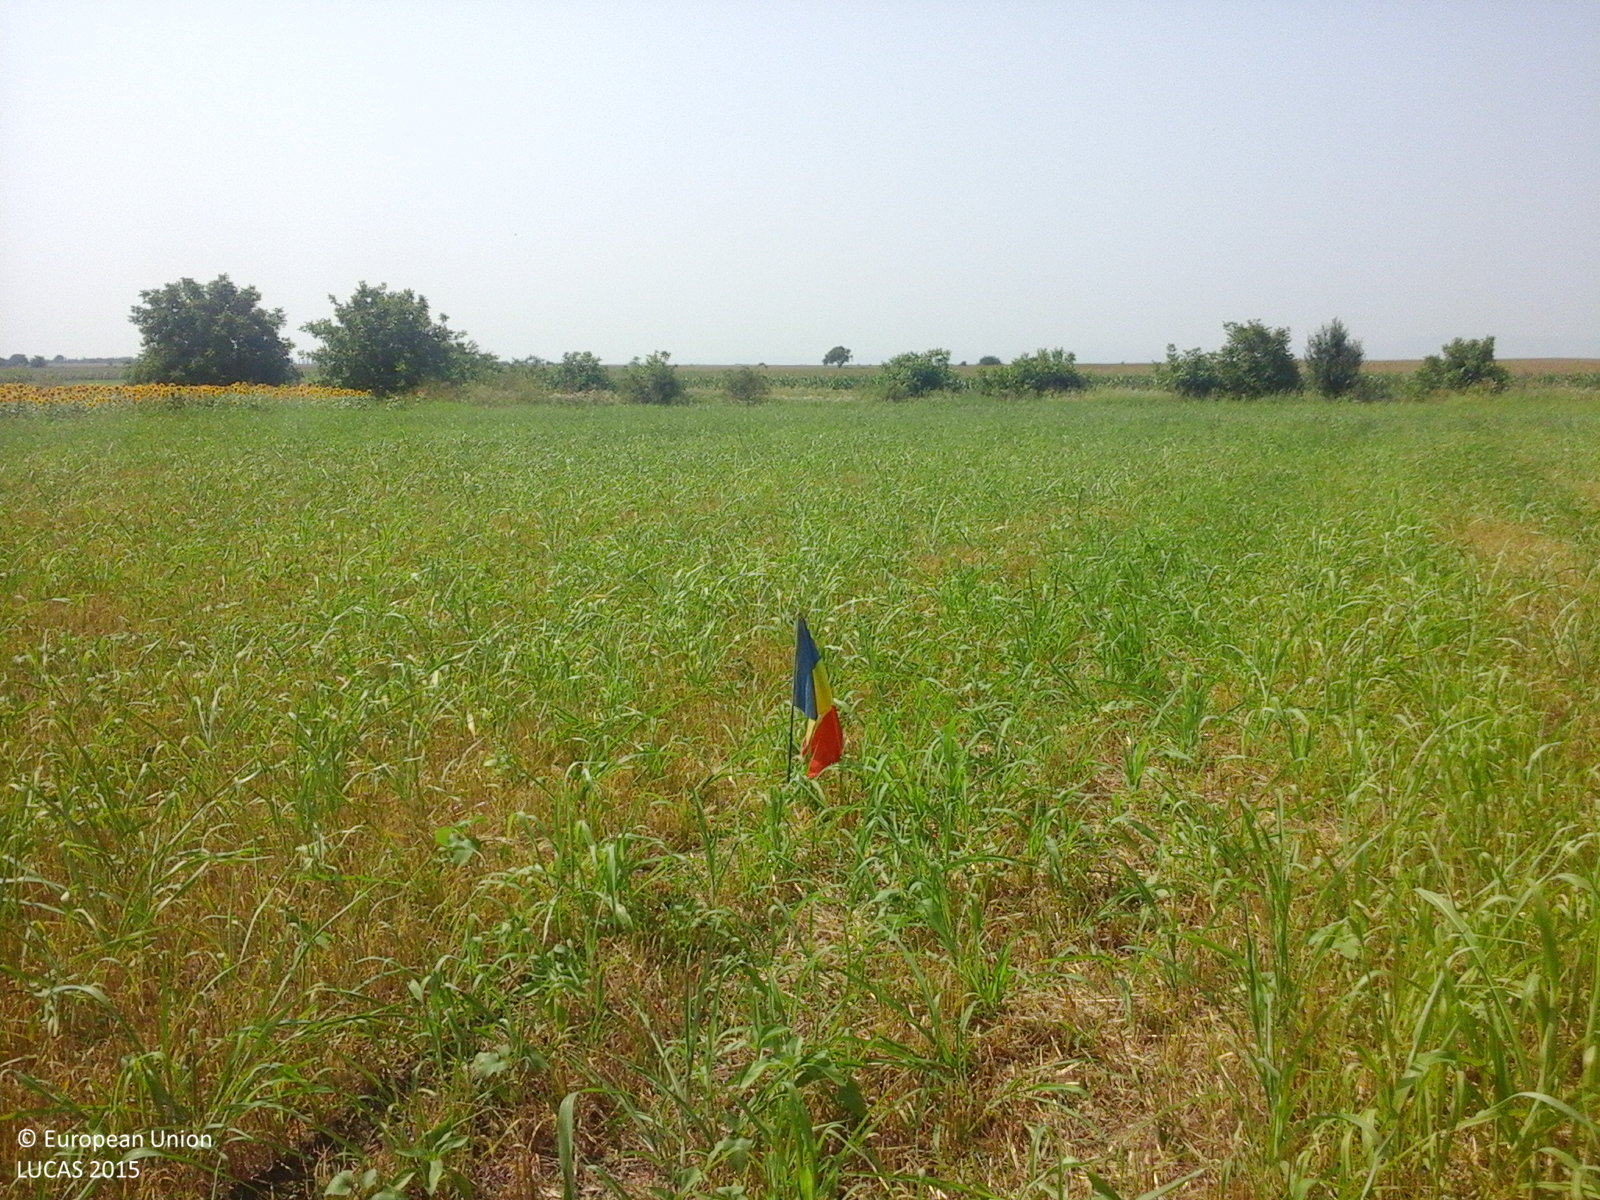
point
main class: Cropland
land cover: Barley
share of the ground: 25 - 50 %
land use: Agriculture (excluding fallow land and kitchen gardens)
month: July
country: RO
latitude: 44.8504
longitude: 26.7649
